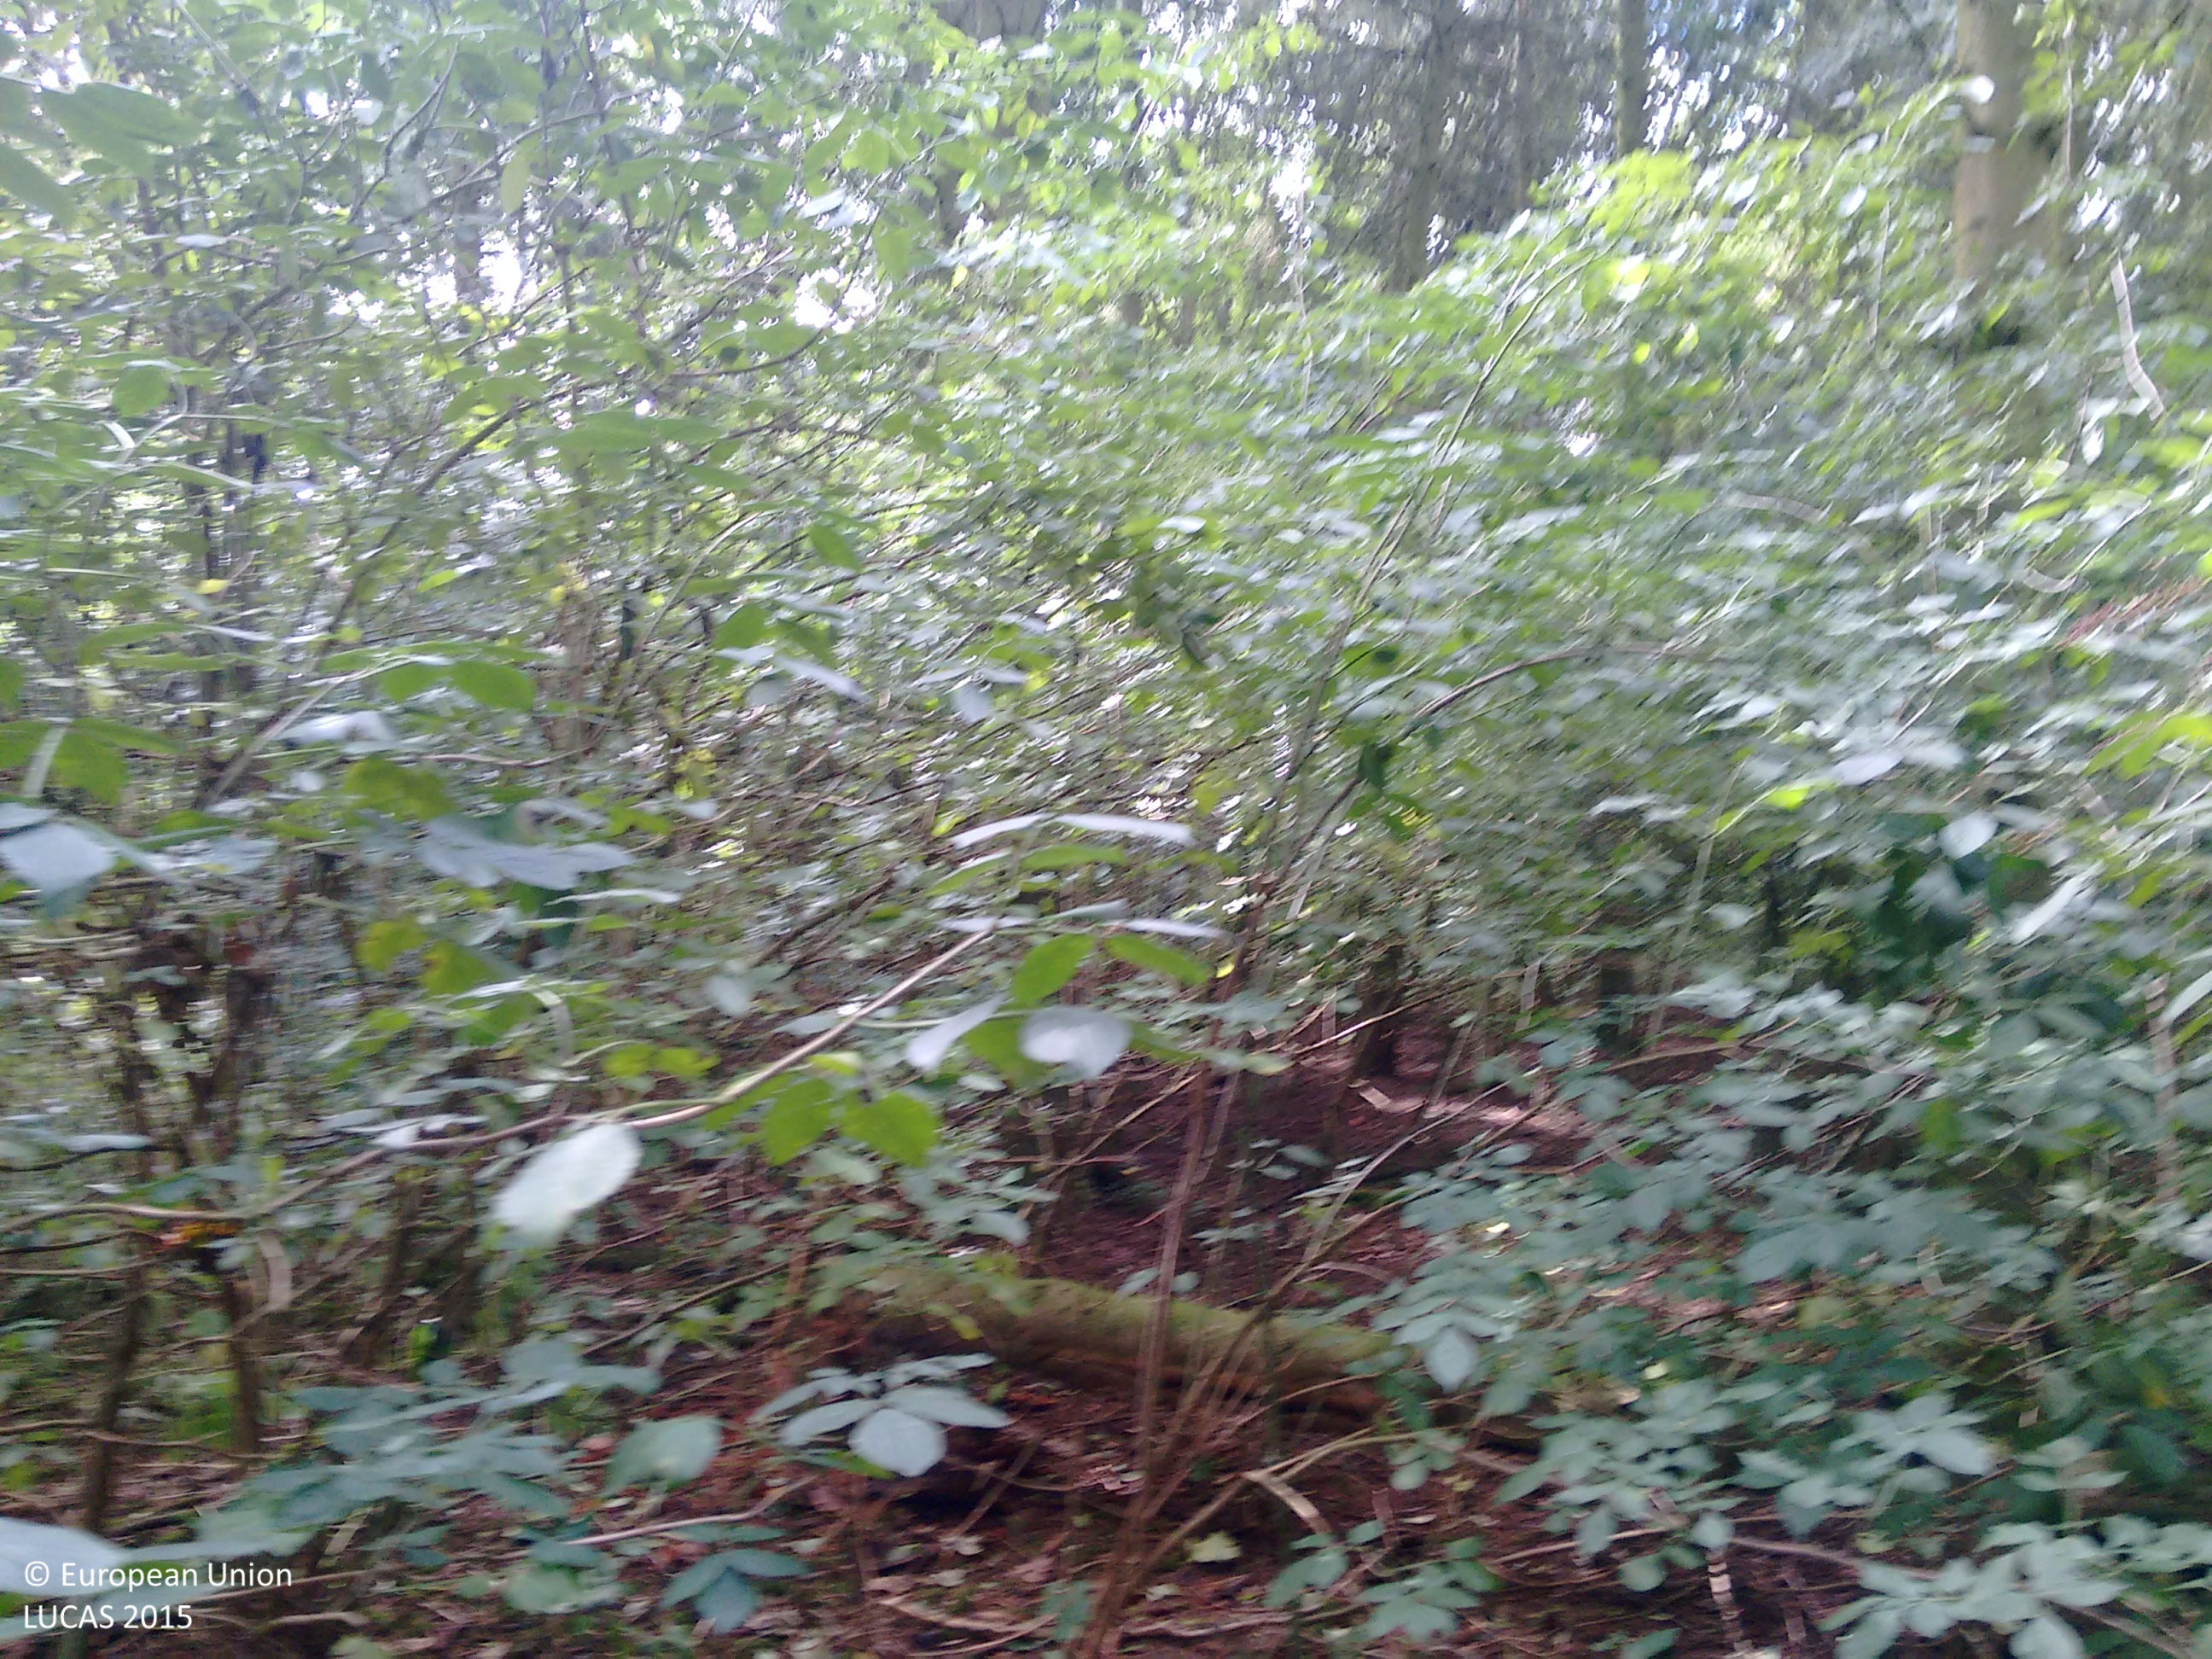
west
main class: Woodland
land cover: Other coniferous woodland
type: exotic forest
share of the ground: > 75 %
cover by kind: coniferous forest trees 85 %, shrubs 10 %, broadleaved forest trees 5 %
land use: Semi-natural and natural areas not in use
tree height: > 5 m
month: August
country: GB
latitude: 52.1598
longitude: 0.5146
